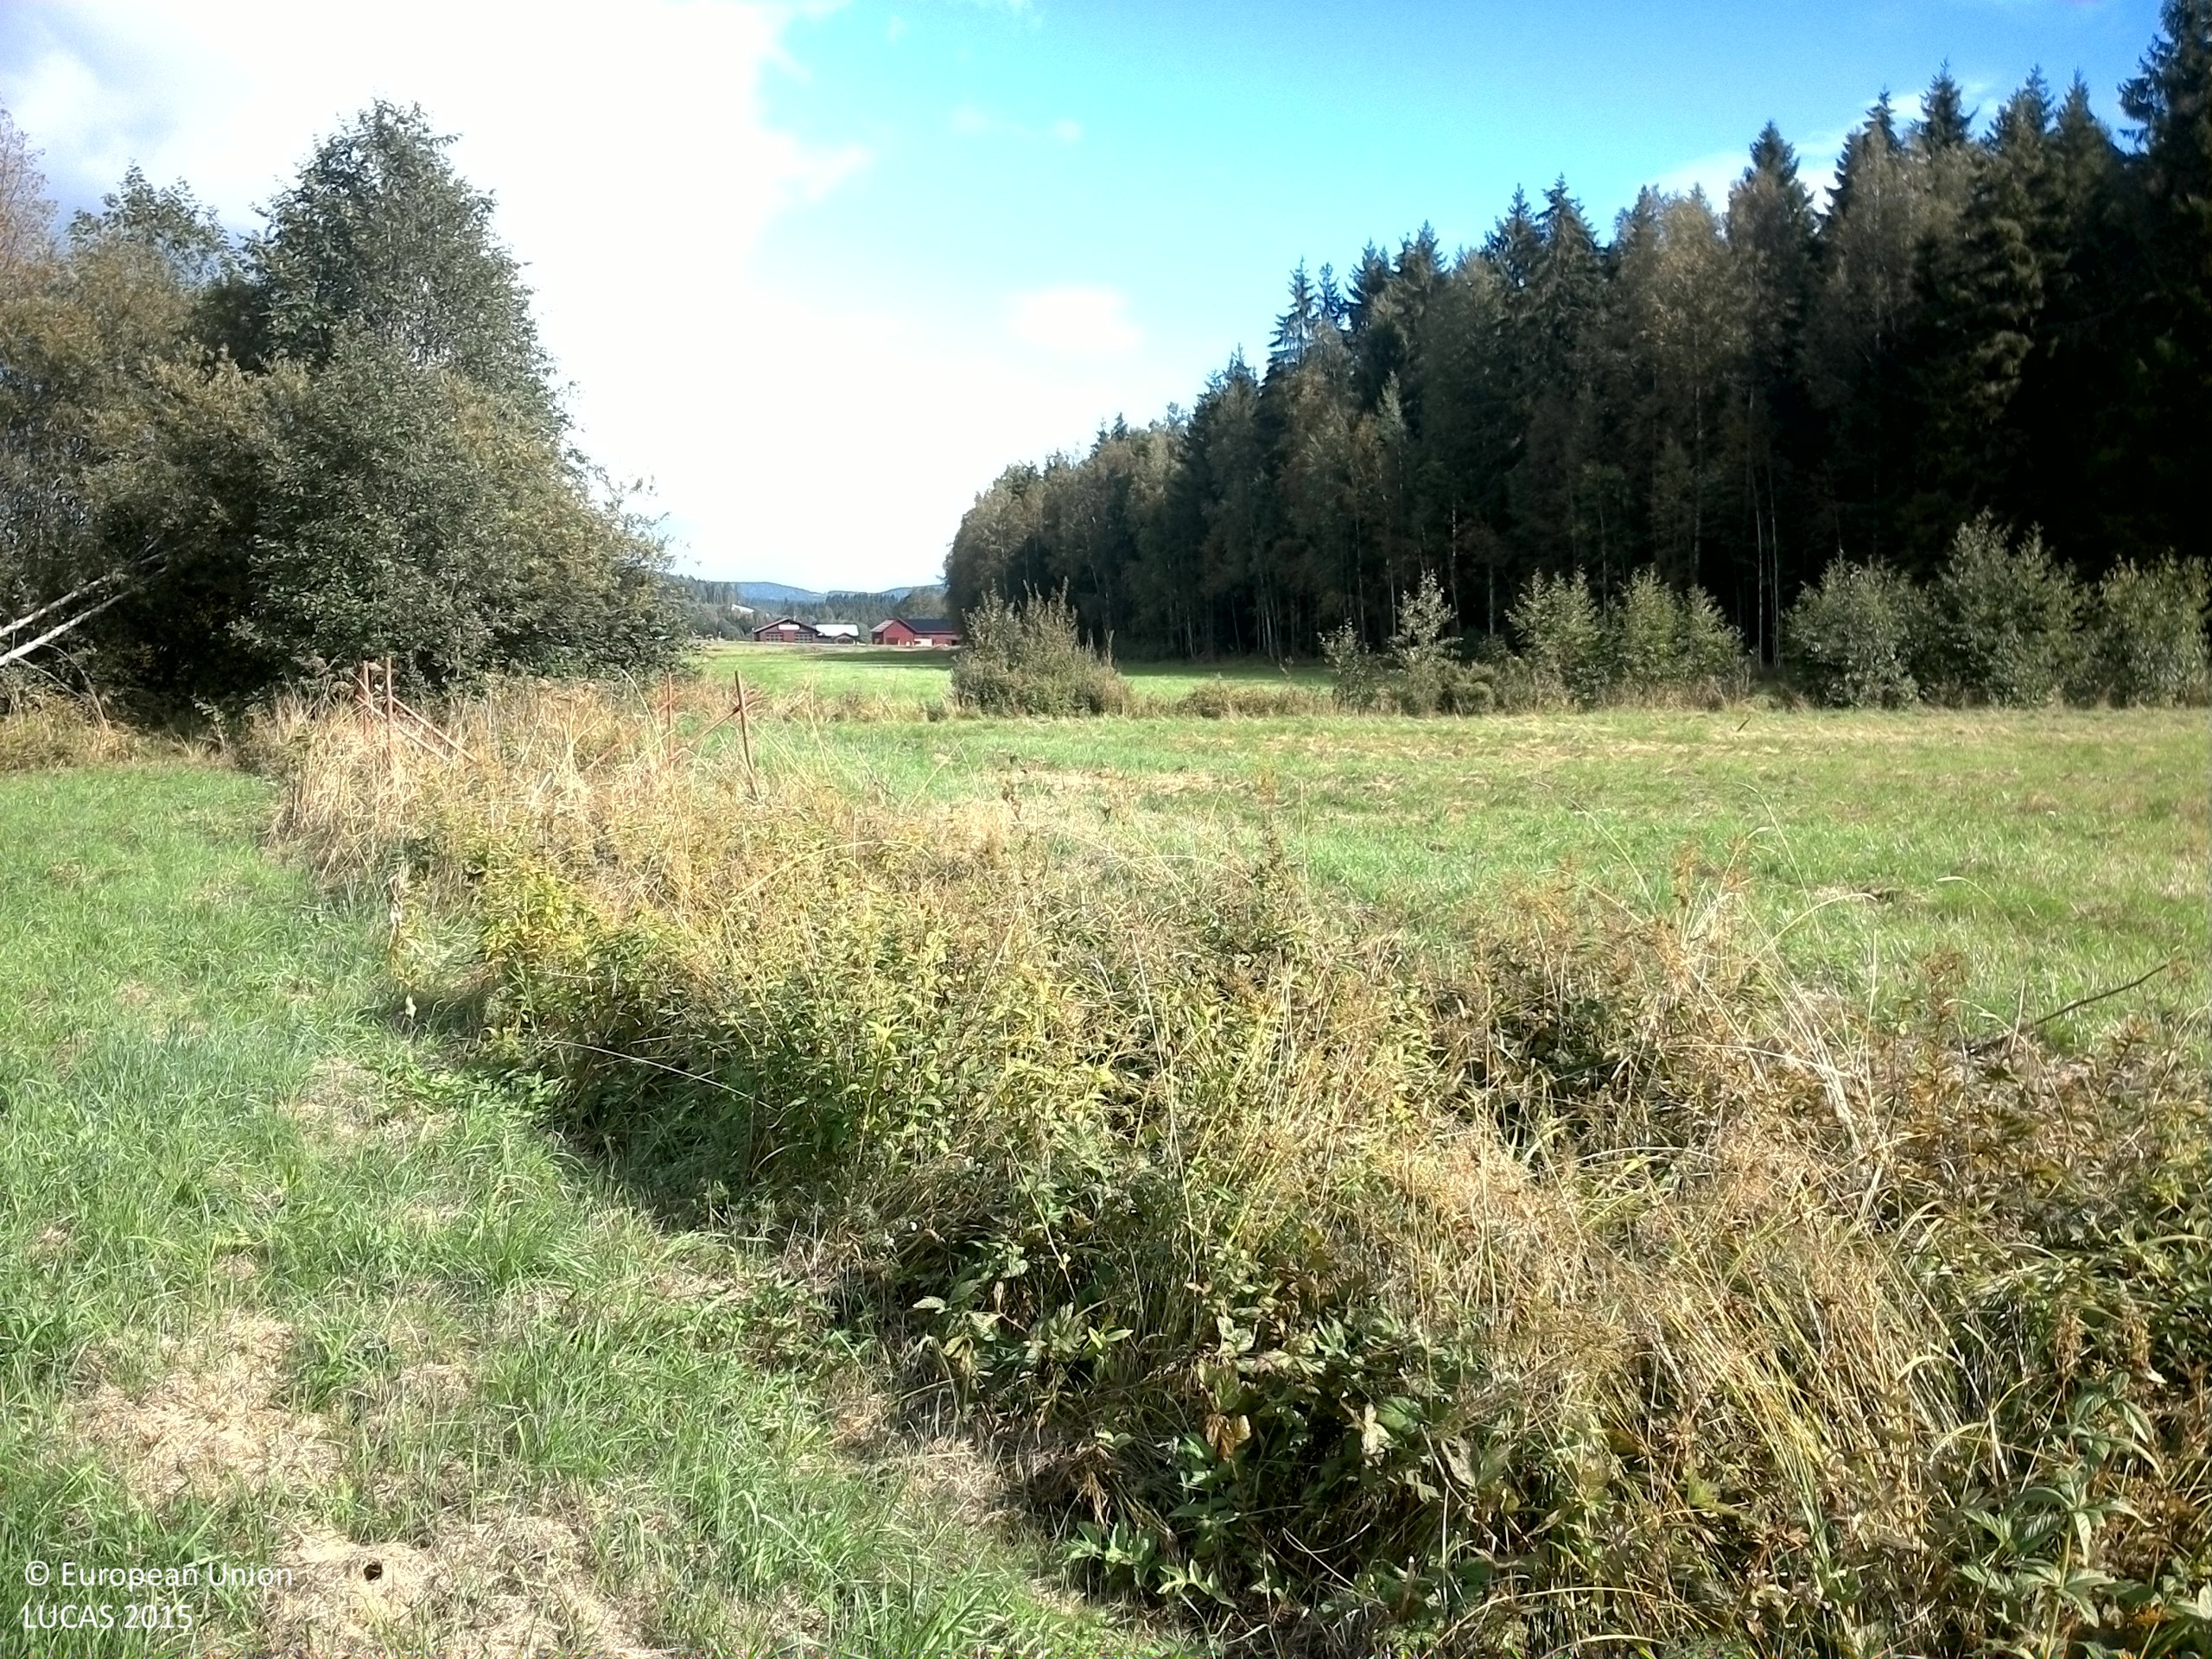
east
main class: Grassland
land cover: Grassland without tree/shrub cover
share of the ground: > 75 %
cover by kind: herbaceous plants 90 %, consolidated bare surface 10 %
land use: Agriculture (excluding fallow land and kitchen gardens)
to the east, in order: Grassland without tree/shrub cover; Ditches and canals; Grassland without tree/shrub cover; Single bushes/trees; Ditches and canals; Grassland without tree/shrub cover; Shrubland with sparse tree cover; Ditches and canals; Spruce dominated mixed woodland
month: September
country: SE
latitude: 59.8025
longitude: 13.1823
